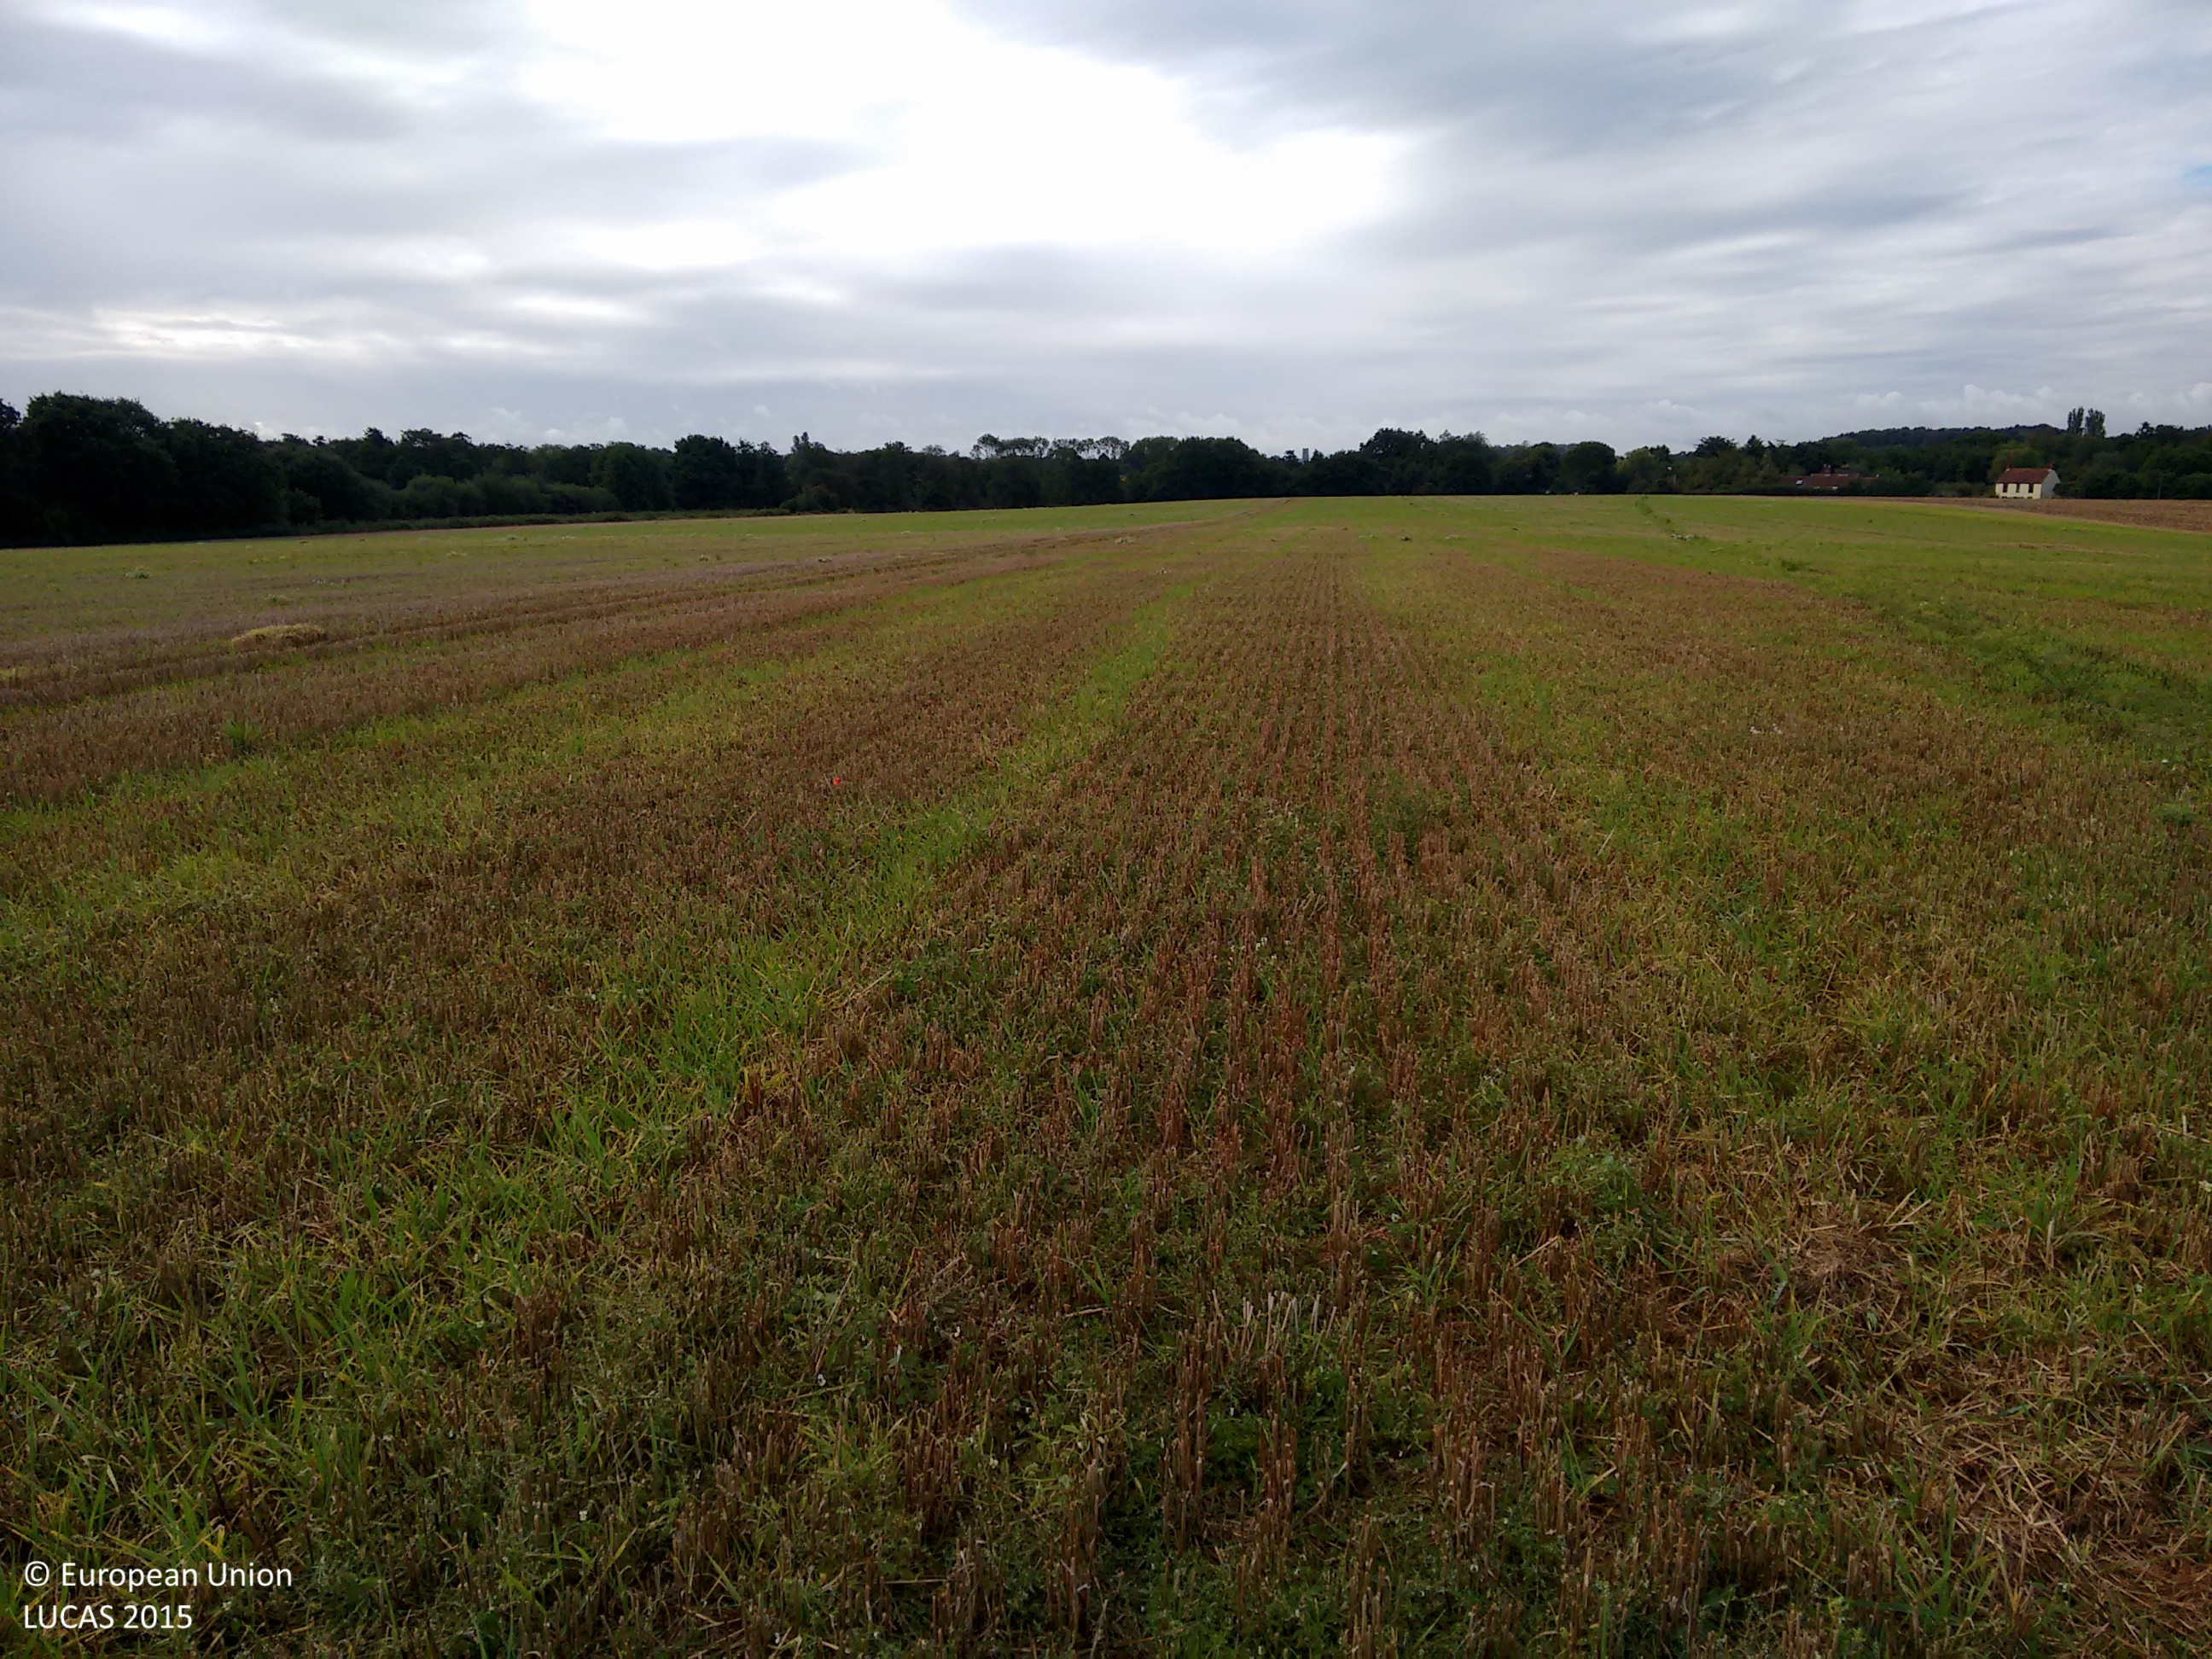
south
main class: Cropland
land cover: Common wheat
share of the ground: > 75 %
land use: Agriculture (excluding fallow land and kitchen gardens)
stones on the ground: 10 - 25 %
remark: Harvested field
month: September
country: GB
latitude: 52.8078
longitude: 1.4209
